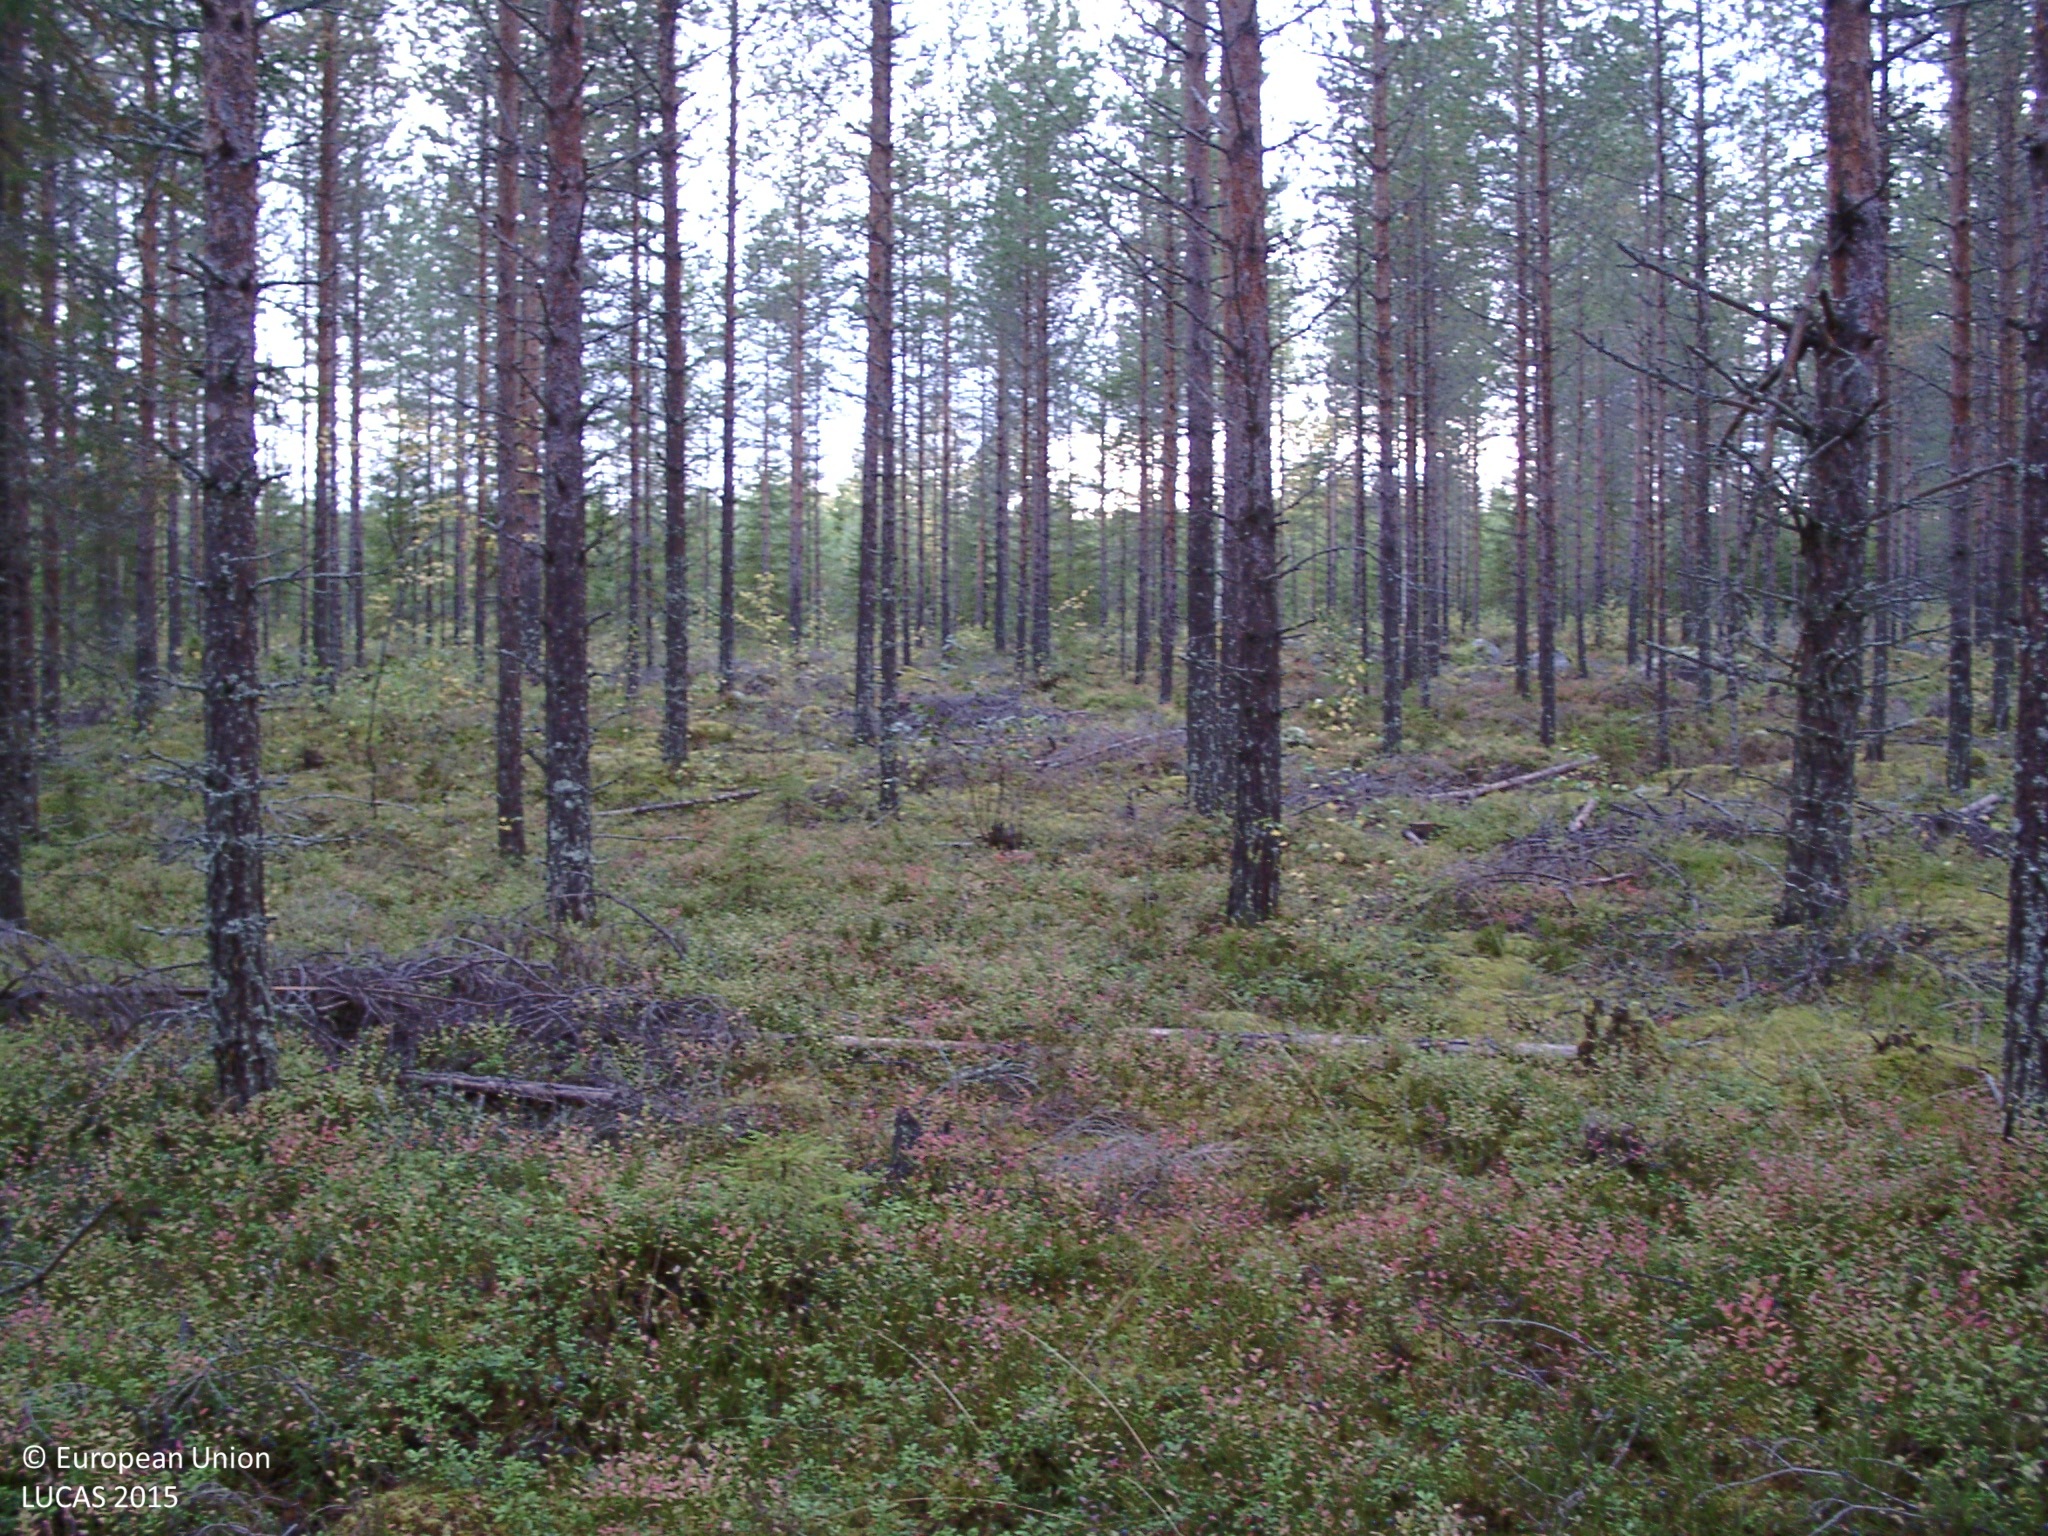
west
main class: Woodland
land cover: Pine dominated coniferous woodland
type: boreal forest
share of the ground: 50 - 75 %
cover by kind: coniferous forest trees 65 %, lichens and mosses 20 %, shrubs 15 %
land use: Forestry
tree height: > 5 m
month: September
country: FI
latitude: 62.7380
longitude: 25.5502
